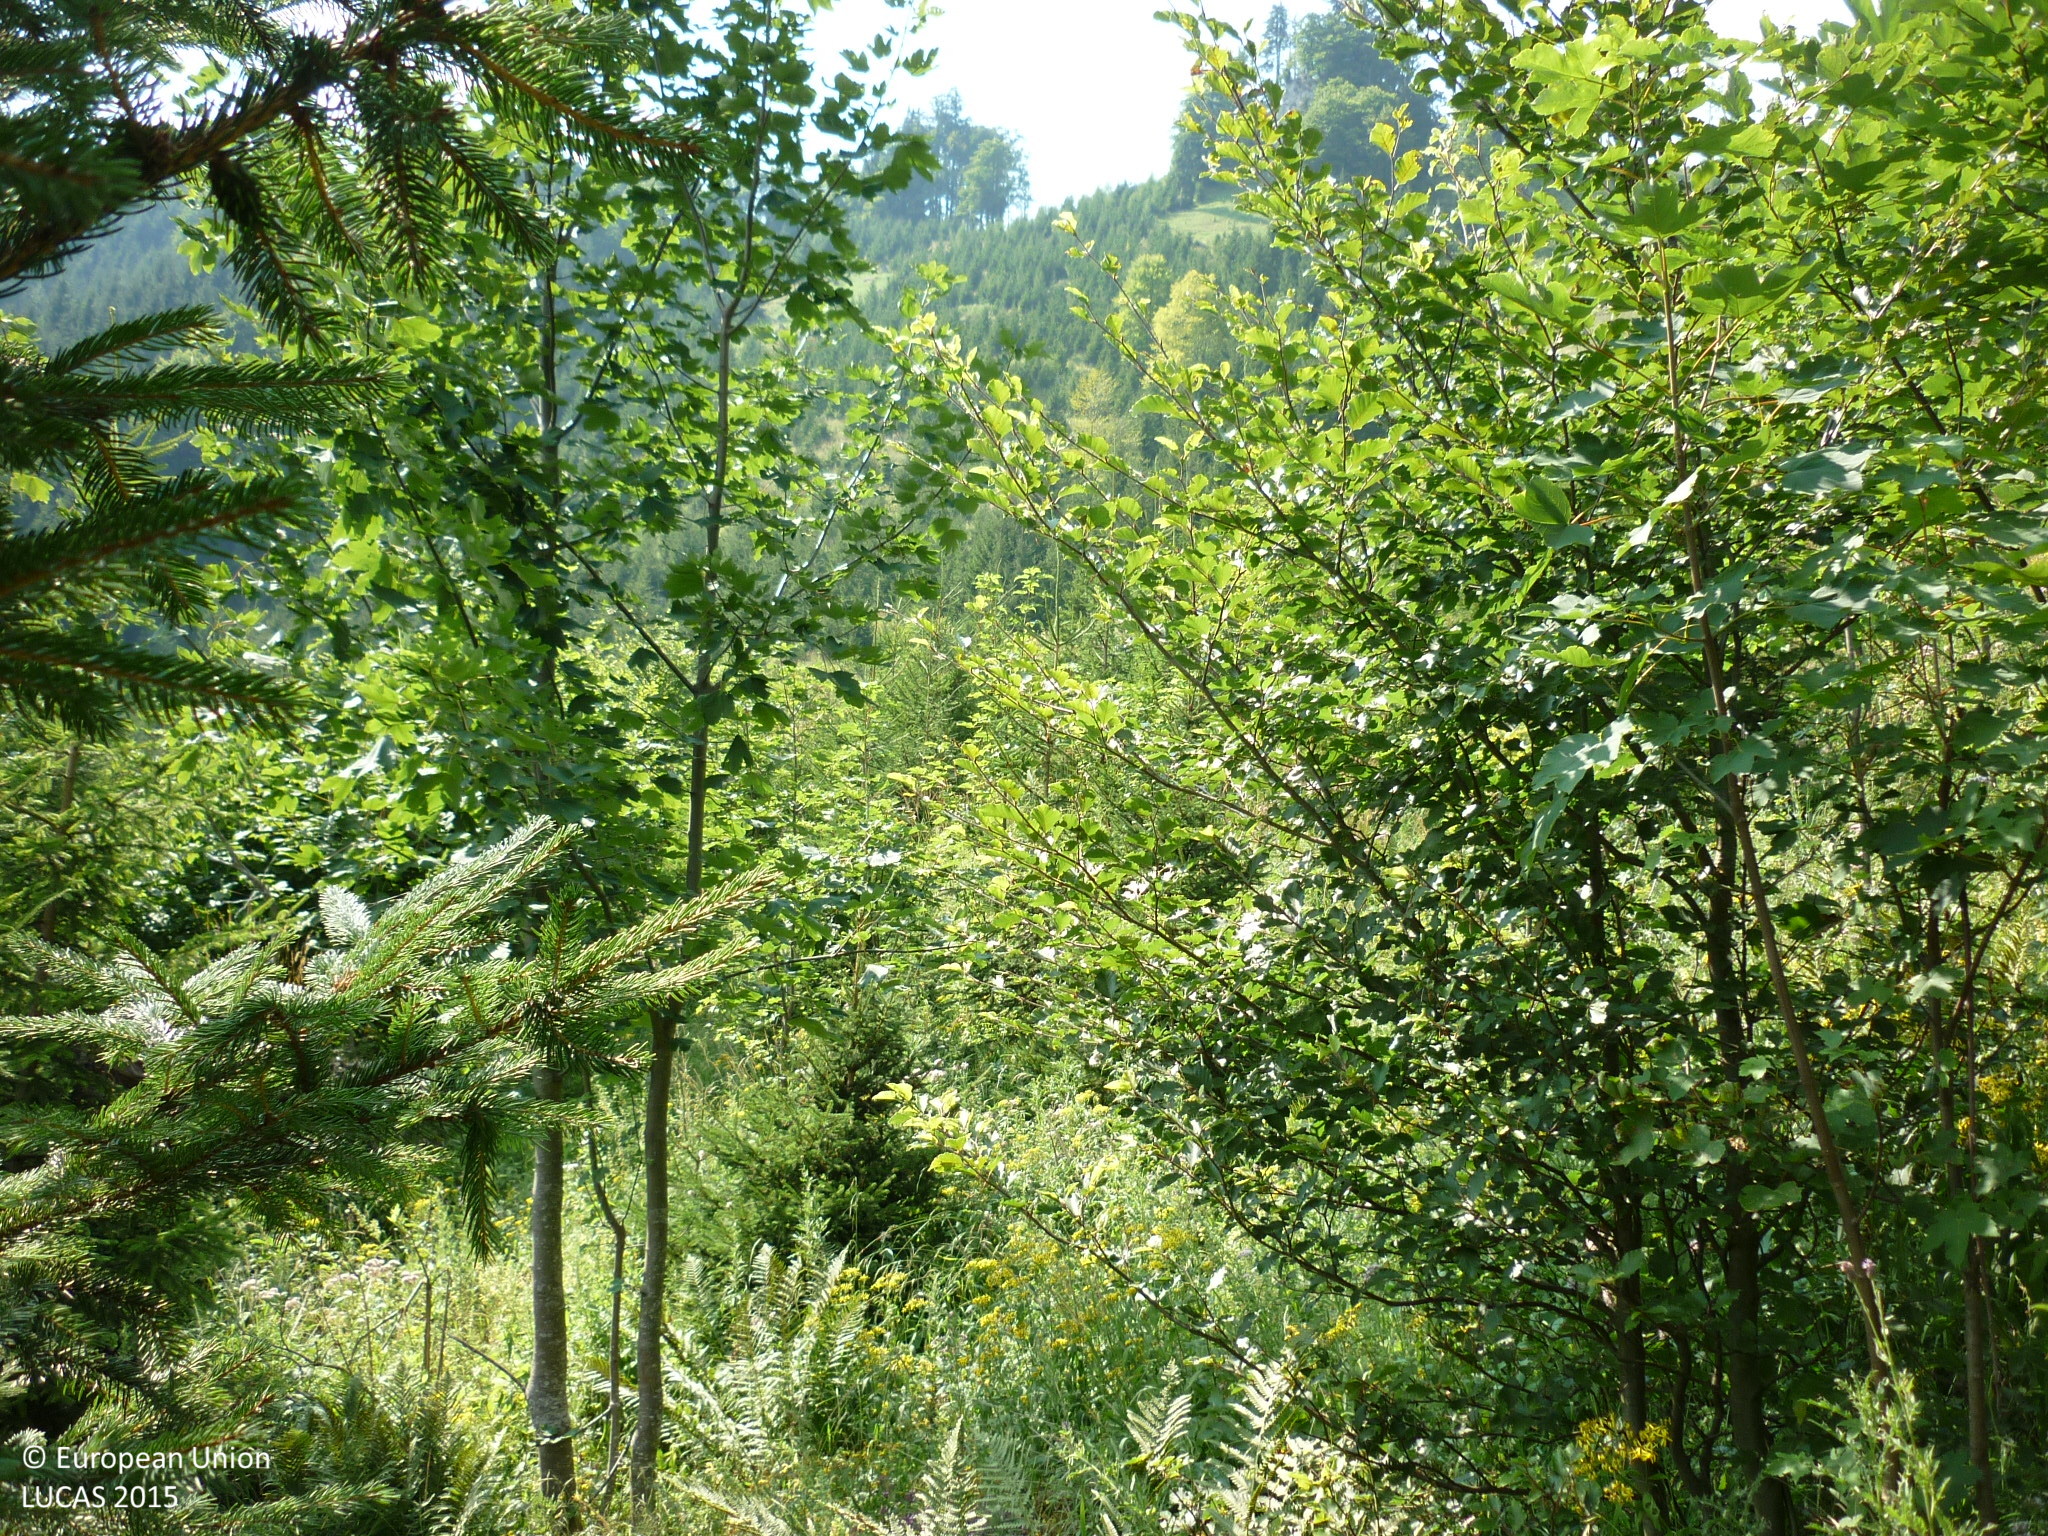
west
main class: Woodland
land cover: Spruce dominated mixed woodland
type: alpine coniferous forest
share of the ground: > 75 %
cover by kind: coniferous forest trees 40 %, broadleaved forest trees 40 %, shrubs 10 %, herbaceous plants 10 %
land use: Forestry
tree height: > 5 m
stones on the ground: 10 - 25 %
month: August
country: AT
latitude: 47.7692
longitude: 14.5498
